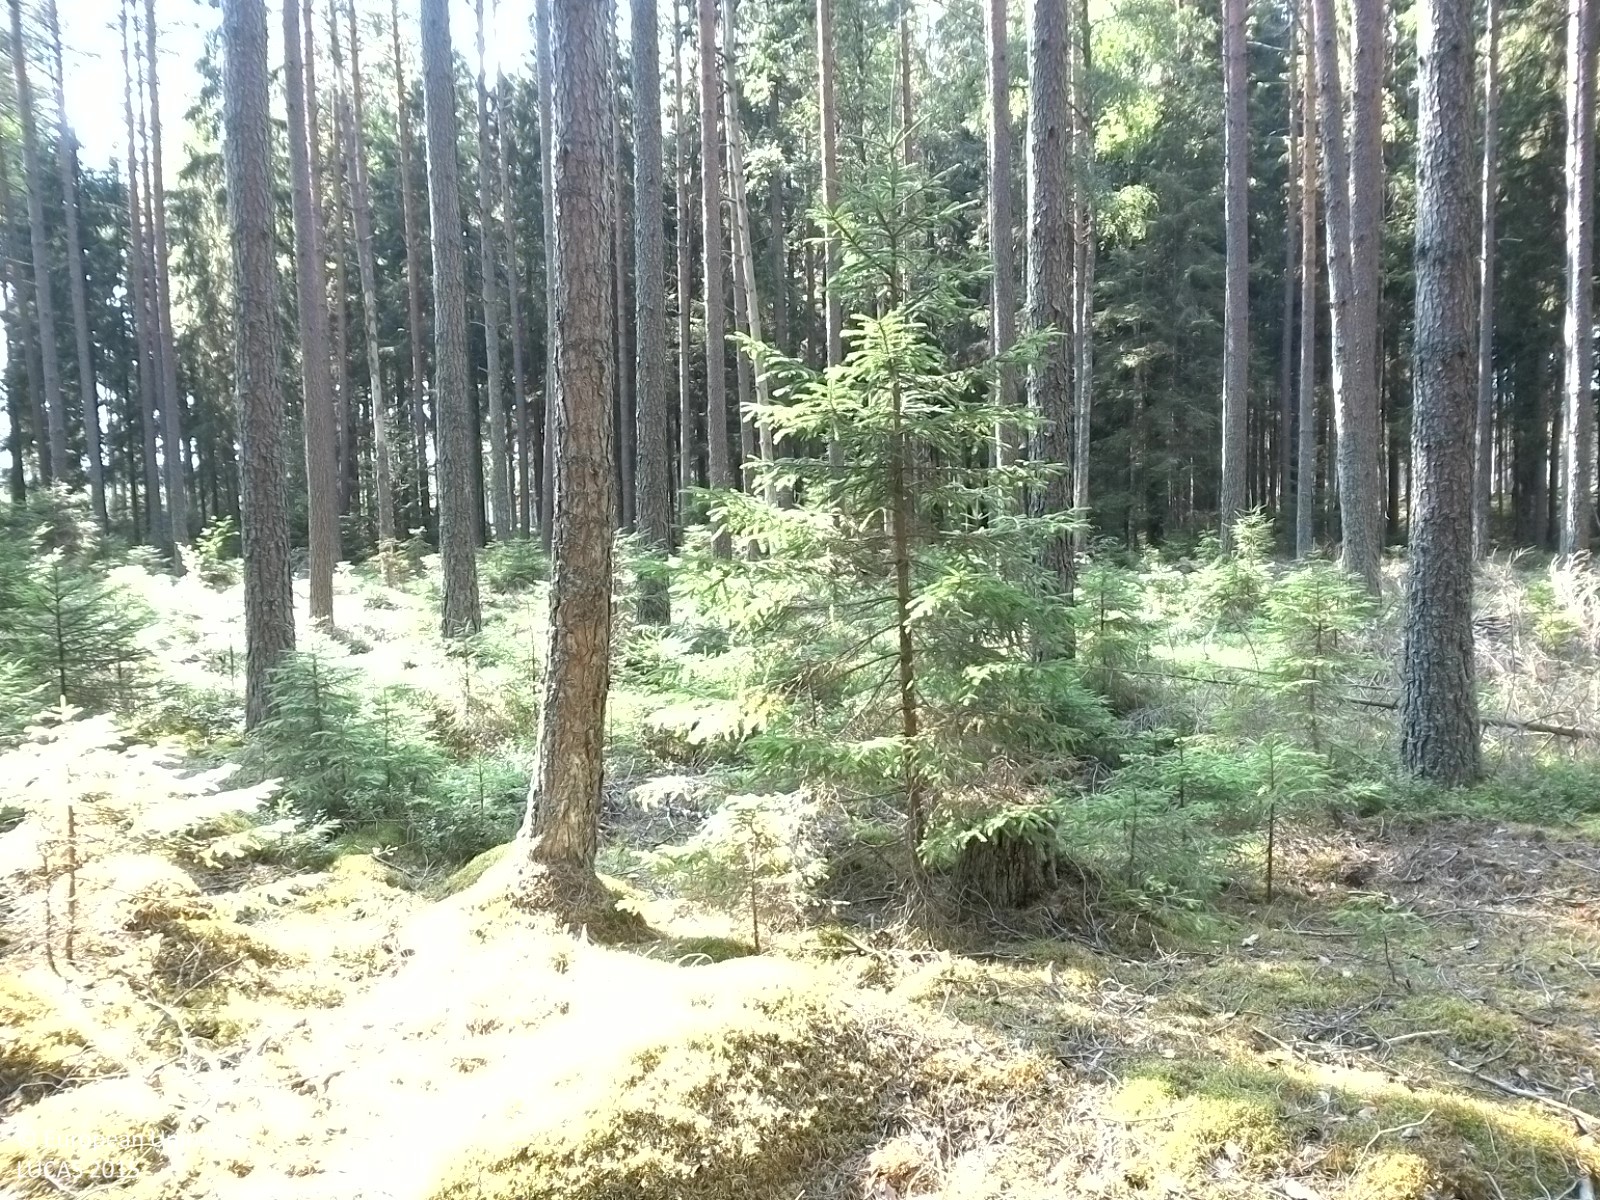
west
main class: Woodland
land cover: Pine dominated coniferous woodland
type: boreal forest
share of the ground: 25 - 50 %
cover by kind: lichens and mosses 40 %, coniferous forest trees 35 %, herbaceous plants 25 %
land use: Forestry
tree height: > 5 m
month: August
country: SE
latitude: 59.0189
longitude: 14.7470
